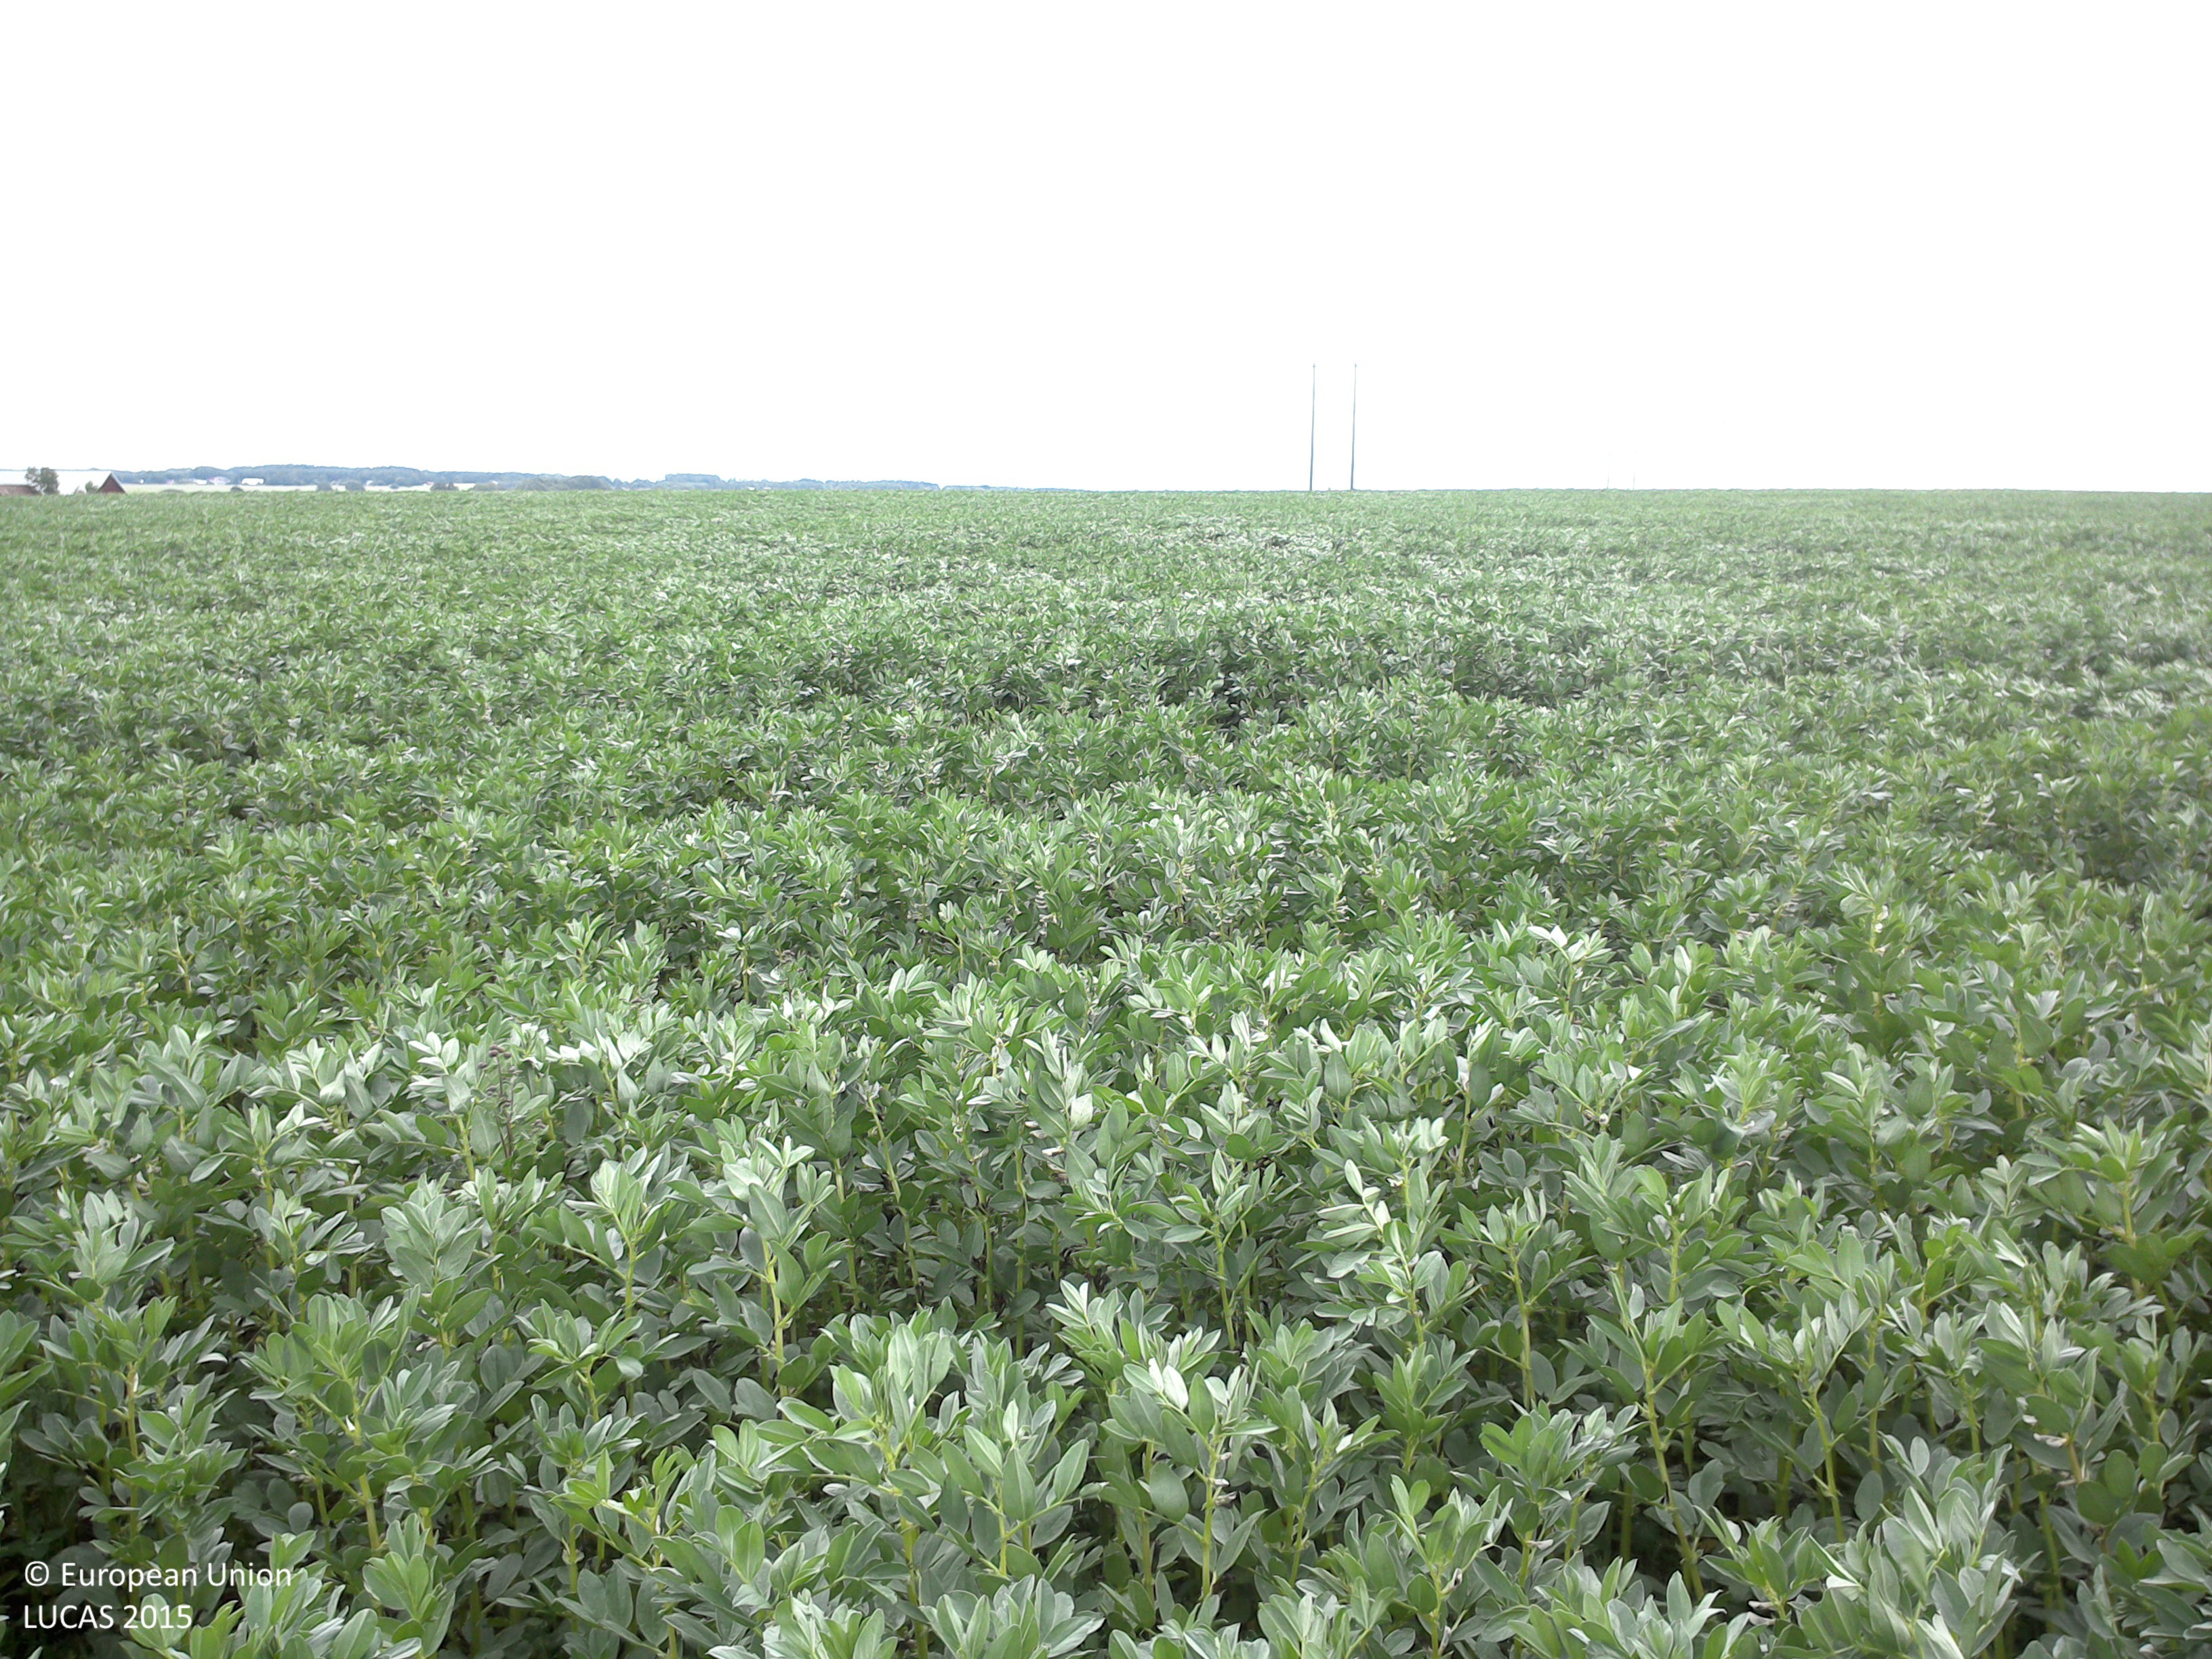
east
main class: Cropland
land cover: Dry pulses
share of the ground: > 75 %
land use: Agriculture (excluding fallow land and kitchen gardens)
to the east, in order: Dry pulses; Electric lines; Arable land (only in case pi)
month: July
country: SE
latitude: 58.4159
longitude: 14.9753
